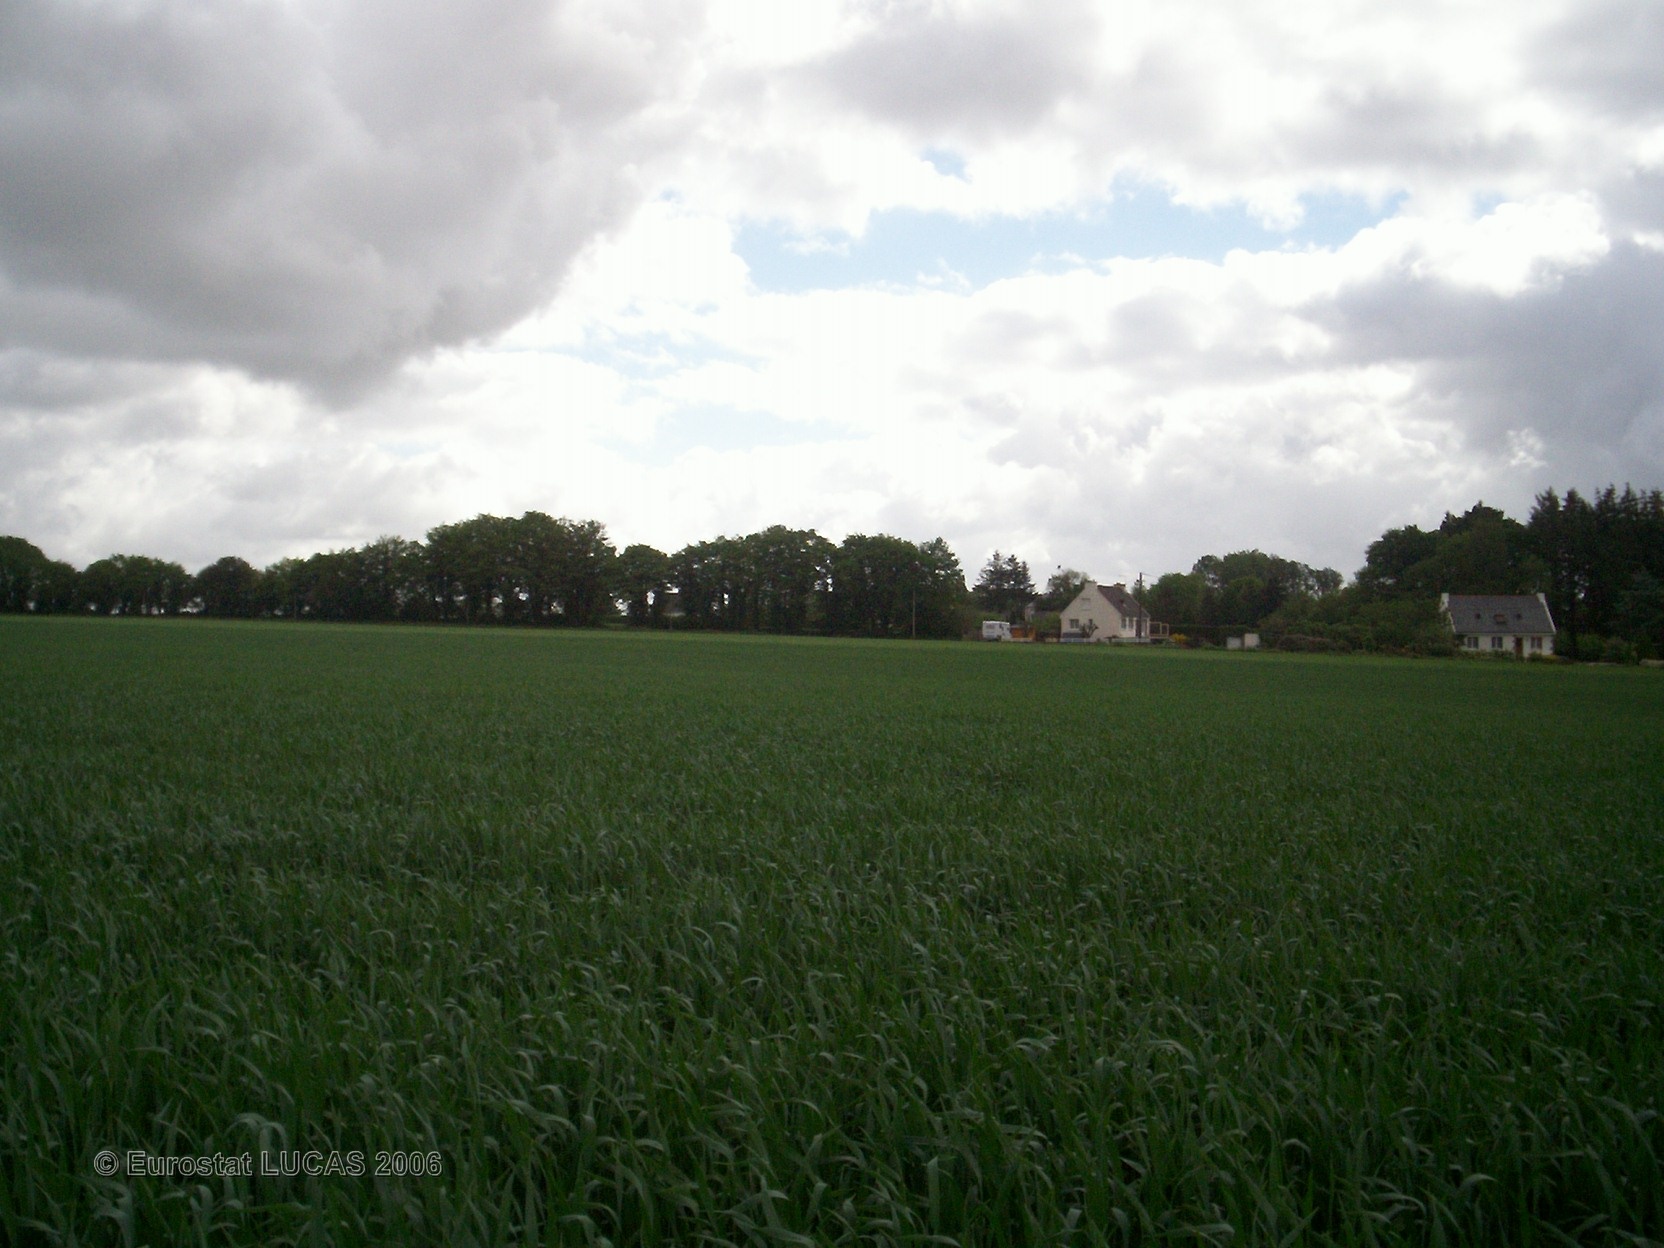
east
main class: Cropland
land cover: Common wheat
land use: Agriculture (excluding fallow land and kitchen gardens)
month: May
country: FR
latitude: 47.9352
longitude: -2.9028
